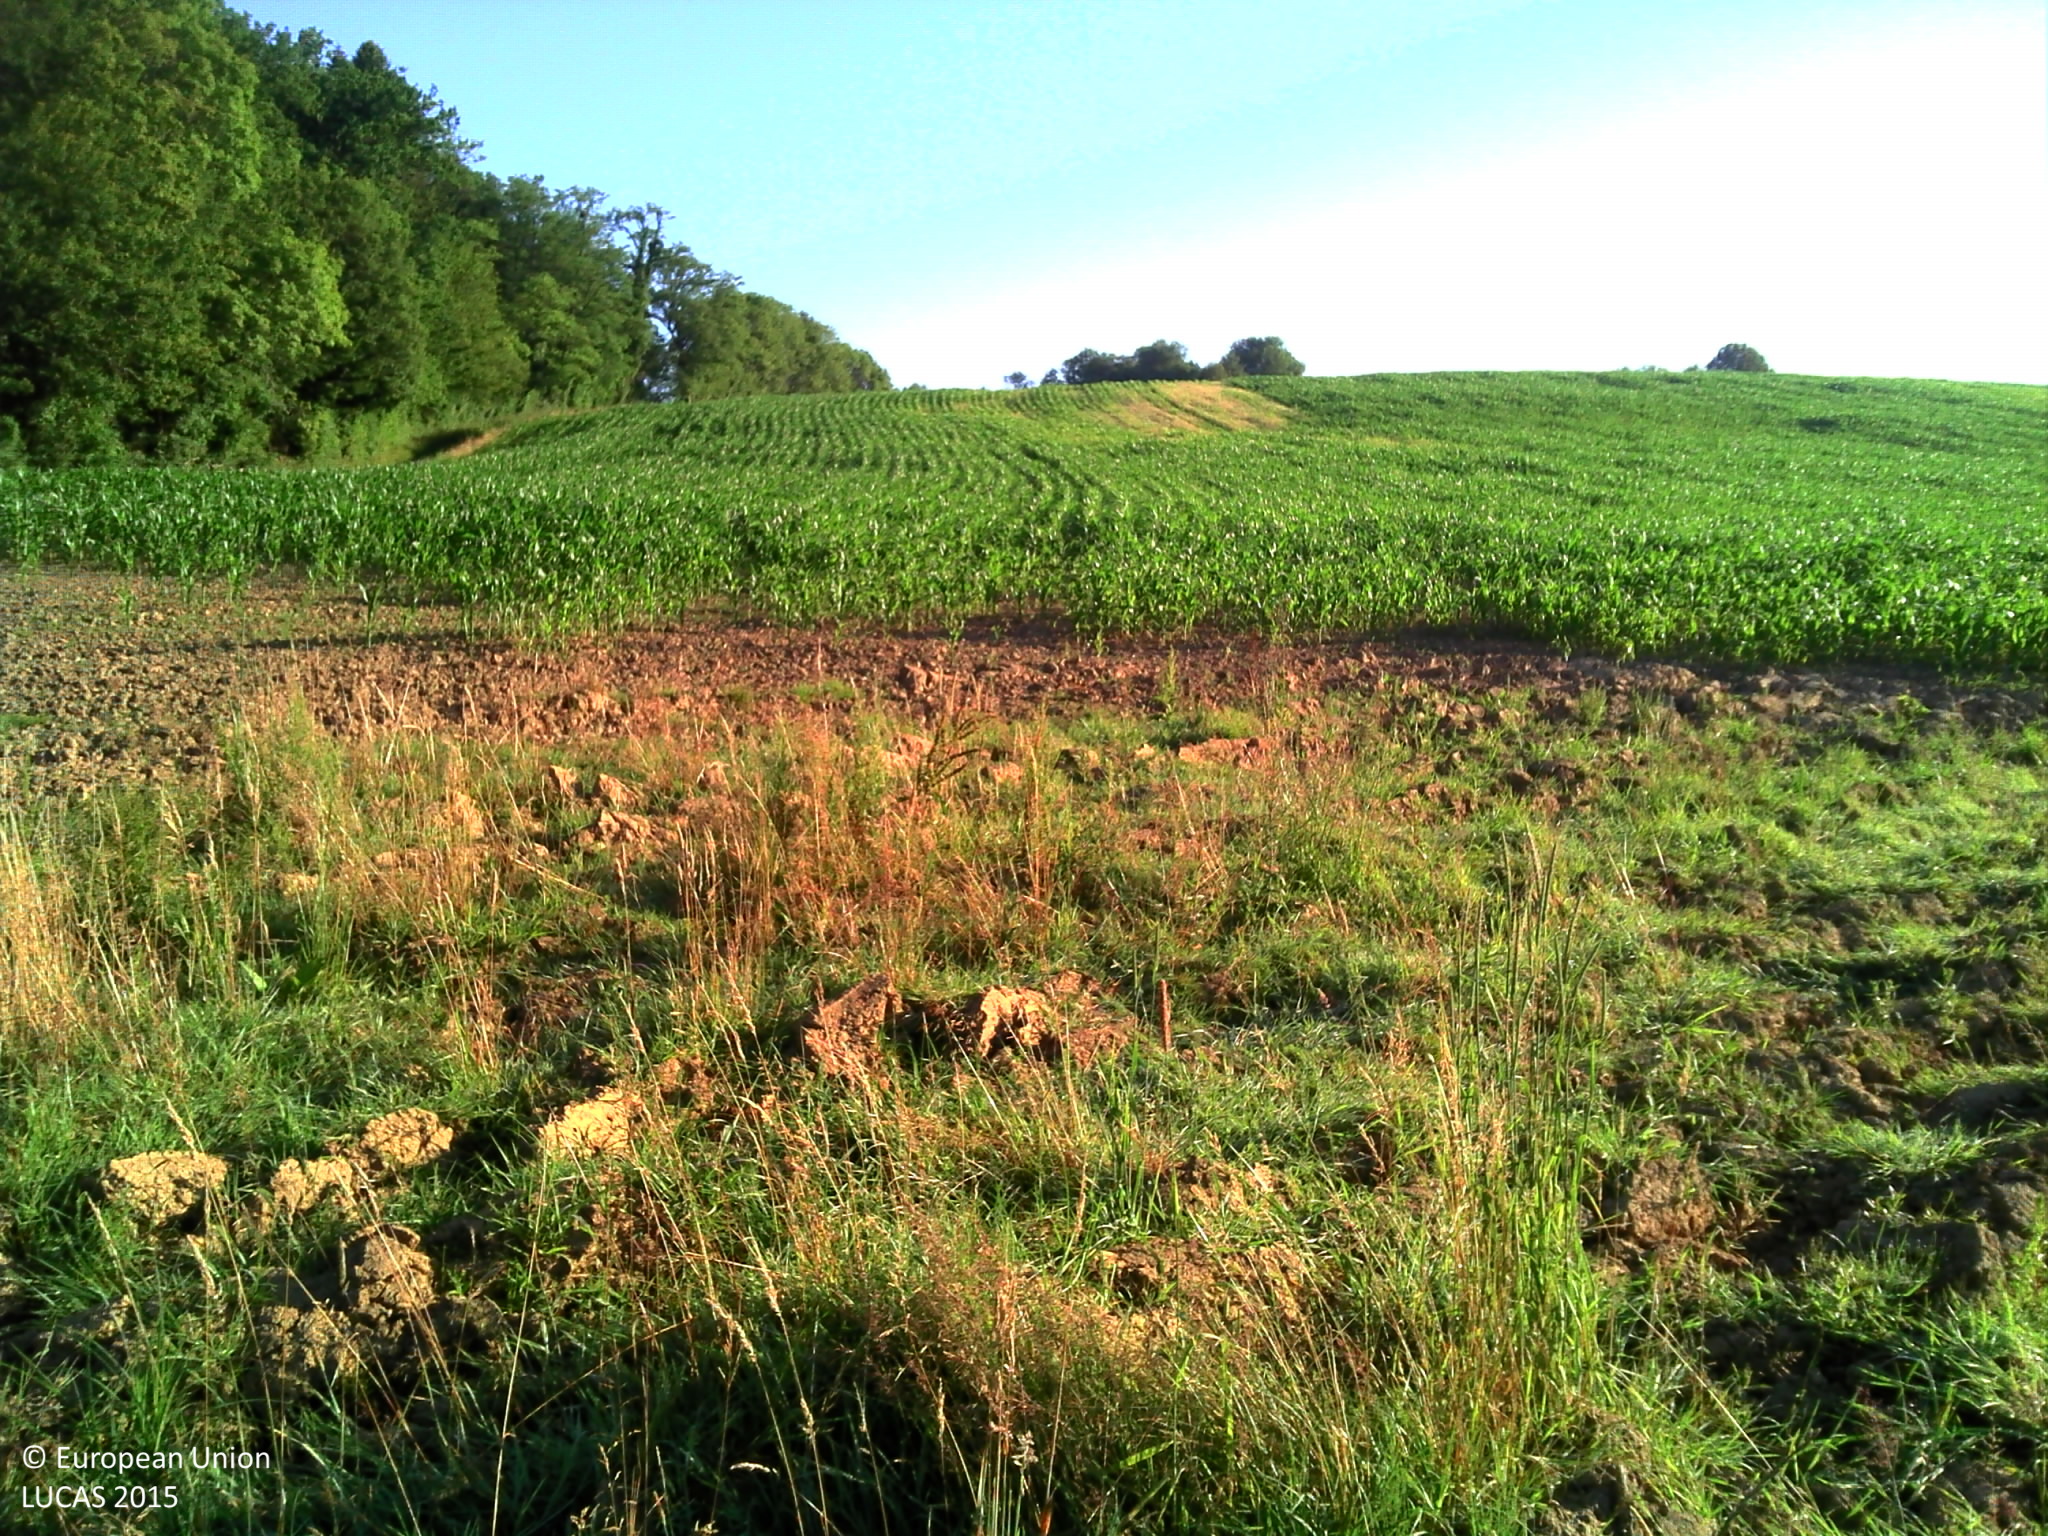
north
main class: Grassland
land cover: Grassland without tree/shrub cover
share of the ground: 50 - 75 %
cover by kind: herbaceous plants 95 %, consolidated bare surface 5 %
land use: Agriculture (excluding fallow land and kitchen gardens)
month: June
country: FR
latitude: 47.3777
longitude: 6.0414
